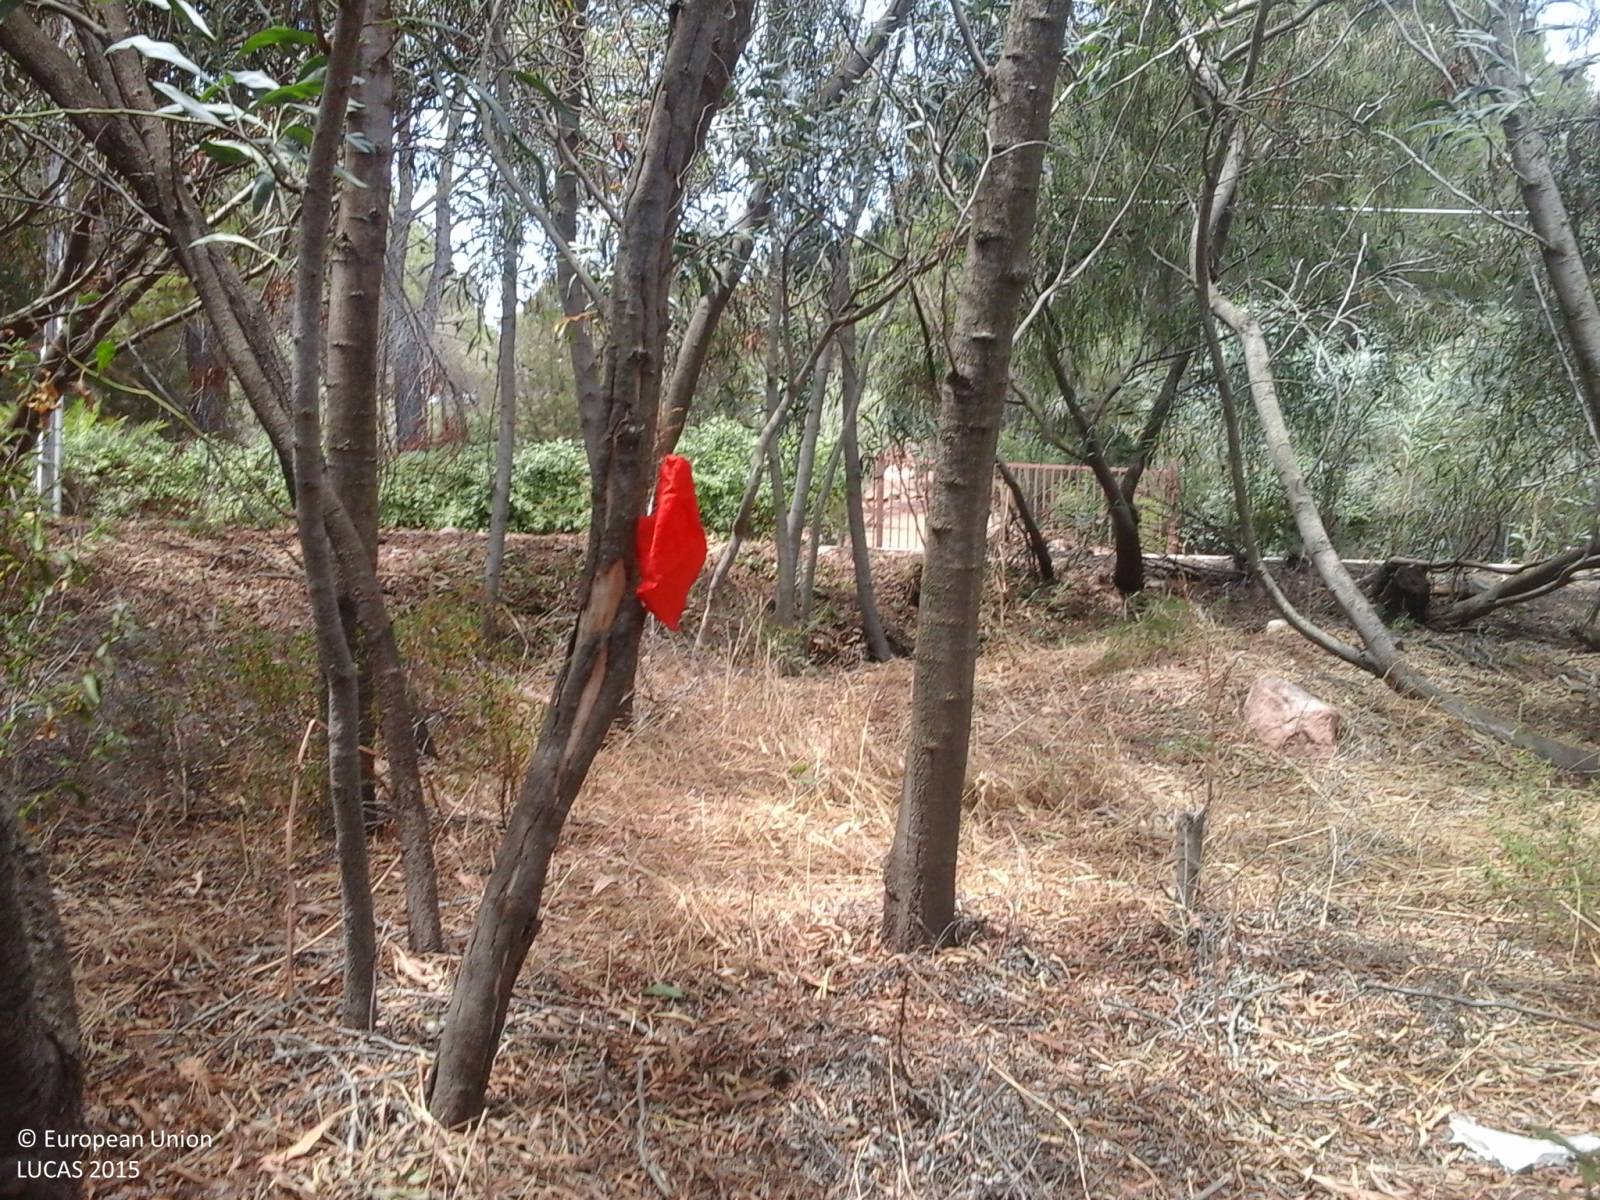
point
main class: Woodland
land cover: Broadleaved woodland
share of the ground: 50 - 75 %
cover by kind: broadleaved forest trees 65 %, unconsolidated bare surface 20 %, shrubs 10 %, herbaceous plants 5 %
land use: Abandoned areas
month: June
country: IT
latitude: 39.3609
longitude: 9.5963
